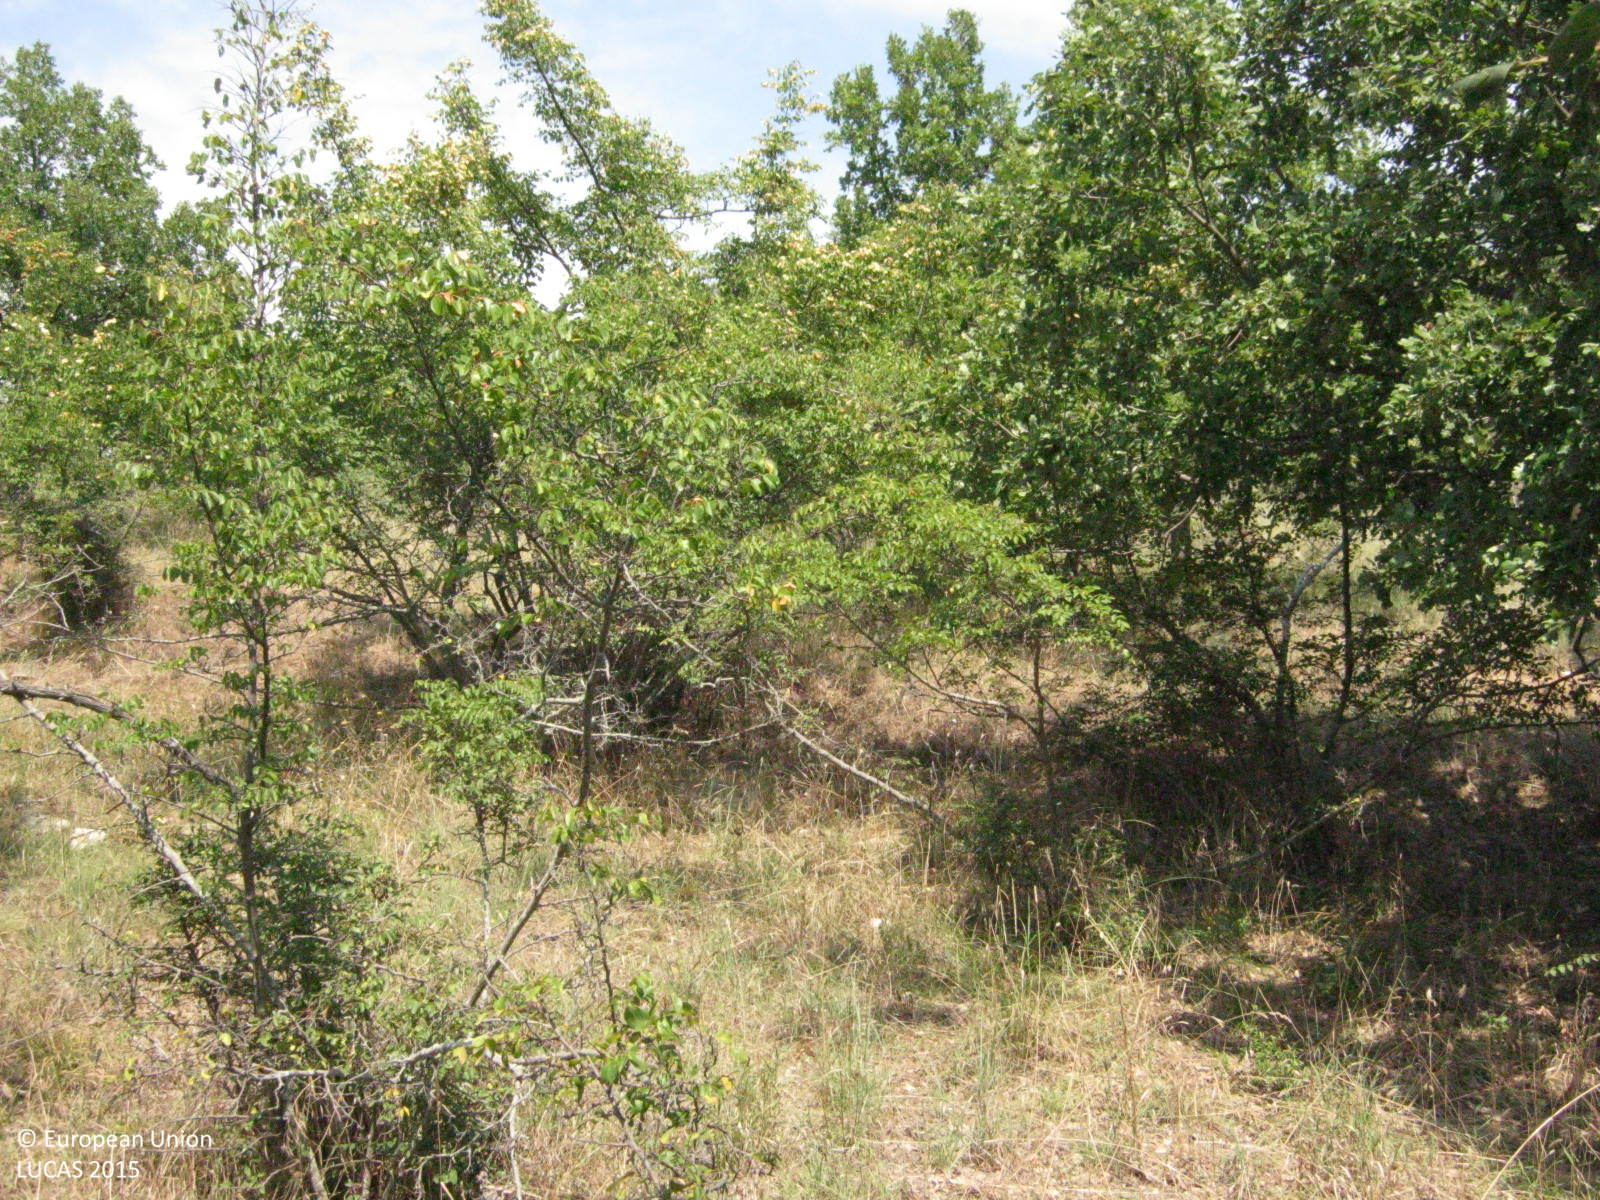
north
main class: Woodland
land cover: Broadleaved woodland
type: thermophilous deciduous forest
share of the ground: 10 - 25 %
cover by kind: herbaceous plants 70 %, broadleaved forest trees 20 %, shrubs 10 %
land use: Semi-natural and natural areas not in use
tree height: > 5 m
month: August
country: GR
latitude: 40.9360
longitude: 22.9927
